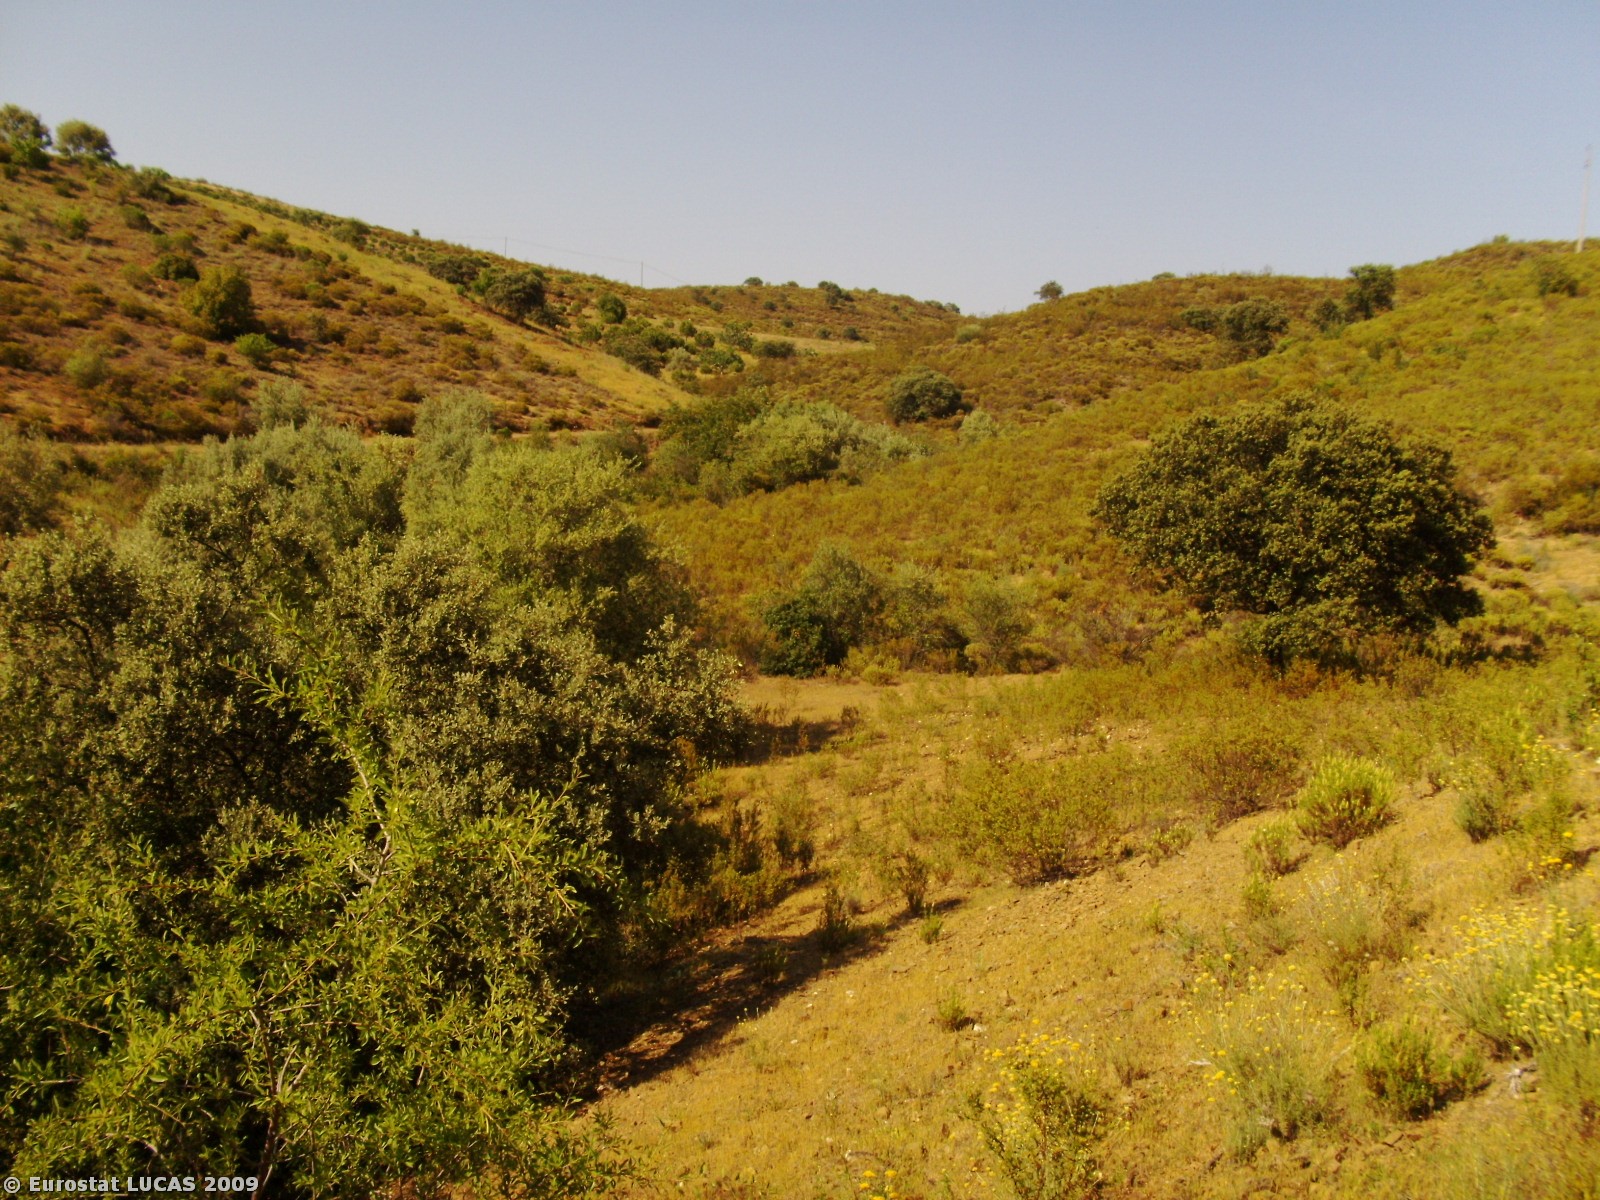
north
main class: Cropland
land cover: Nuts trees
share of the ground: < 10 %
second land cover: Spontaneously vegetated surfaces
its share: > 75 %
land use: Agriculture (excluding fallow land and kitchen gardens)
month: May
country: PT
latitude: 37.3910
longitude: -7.4801
